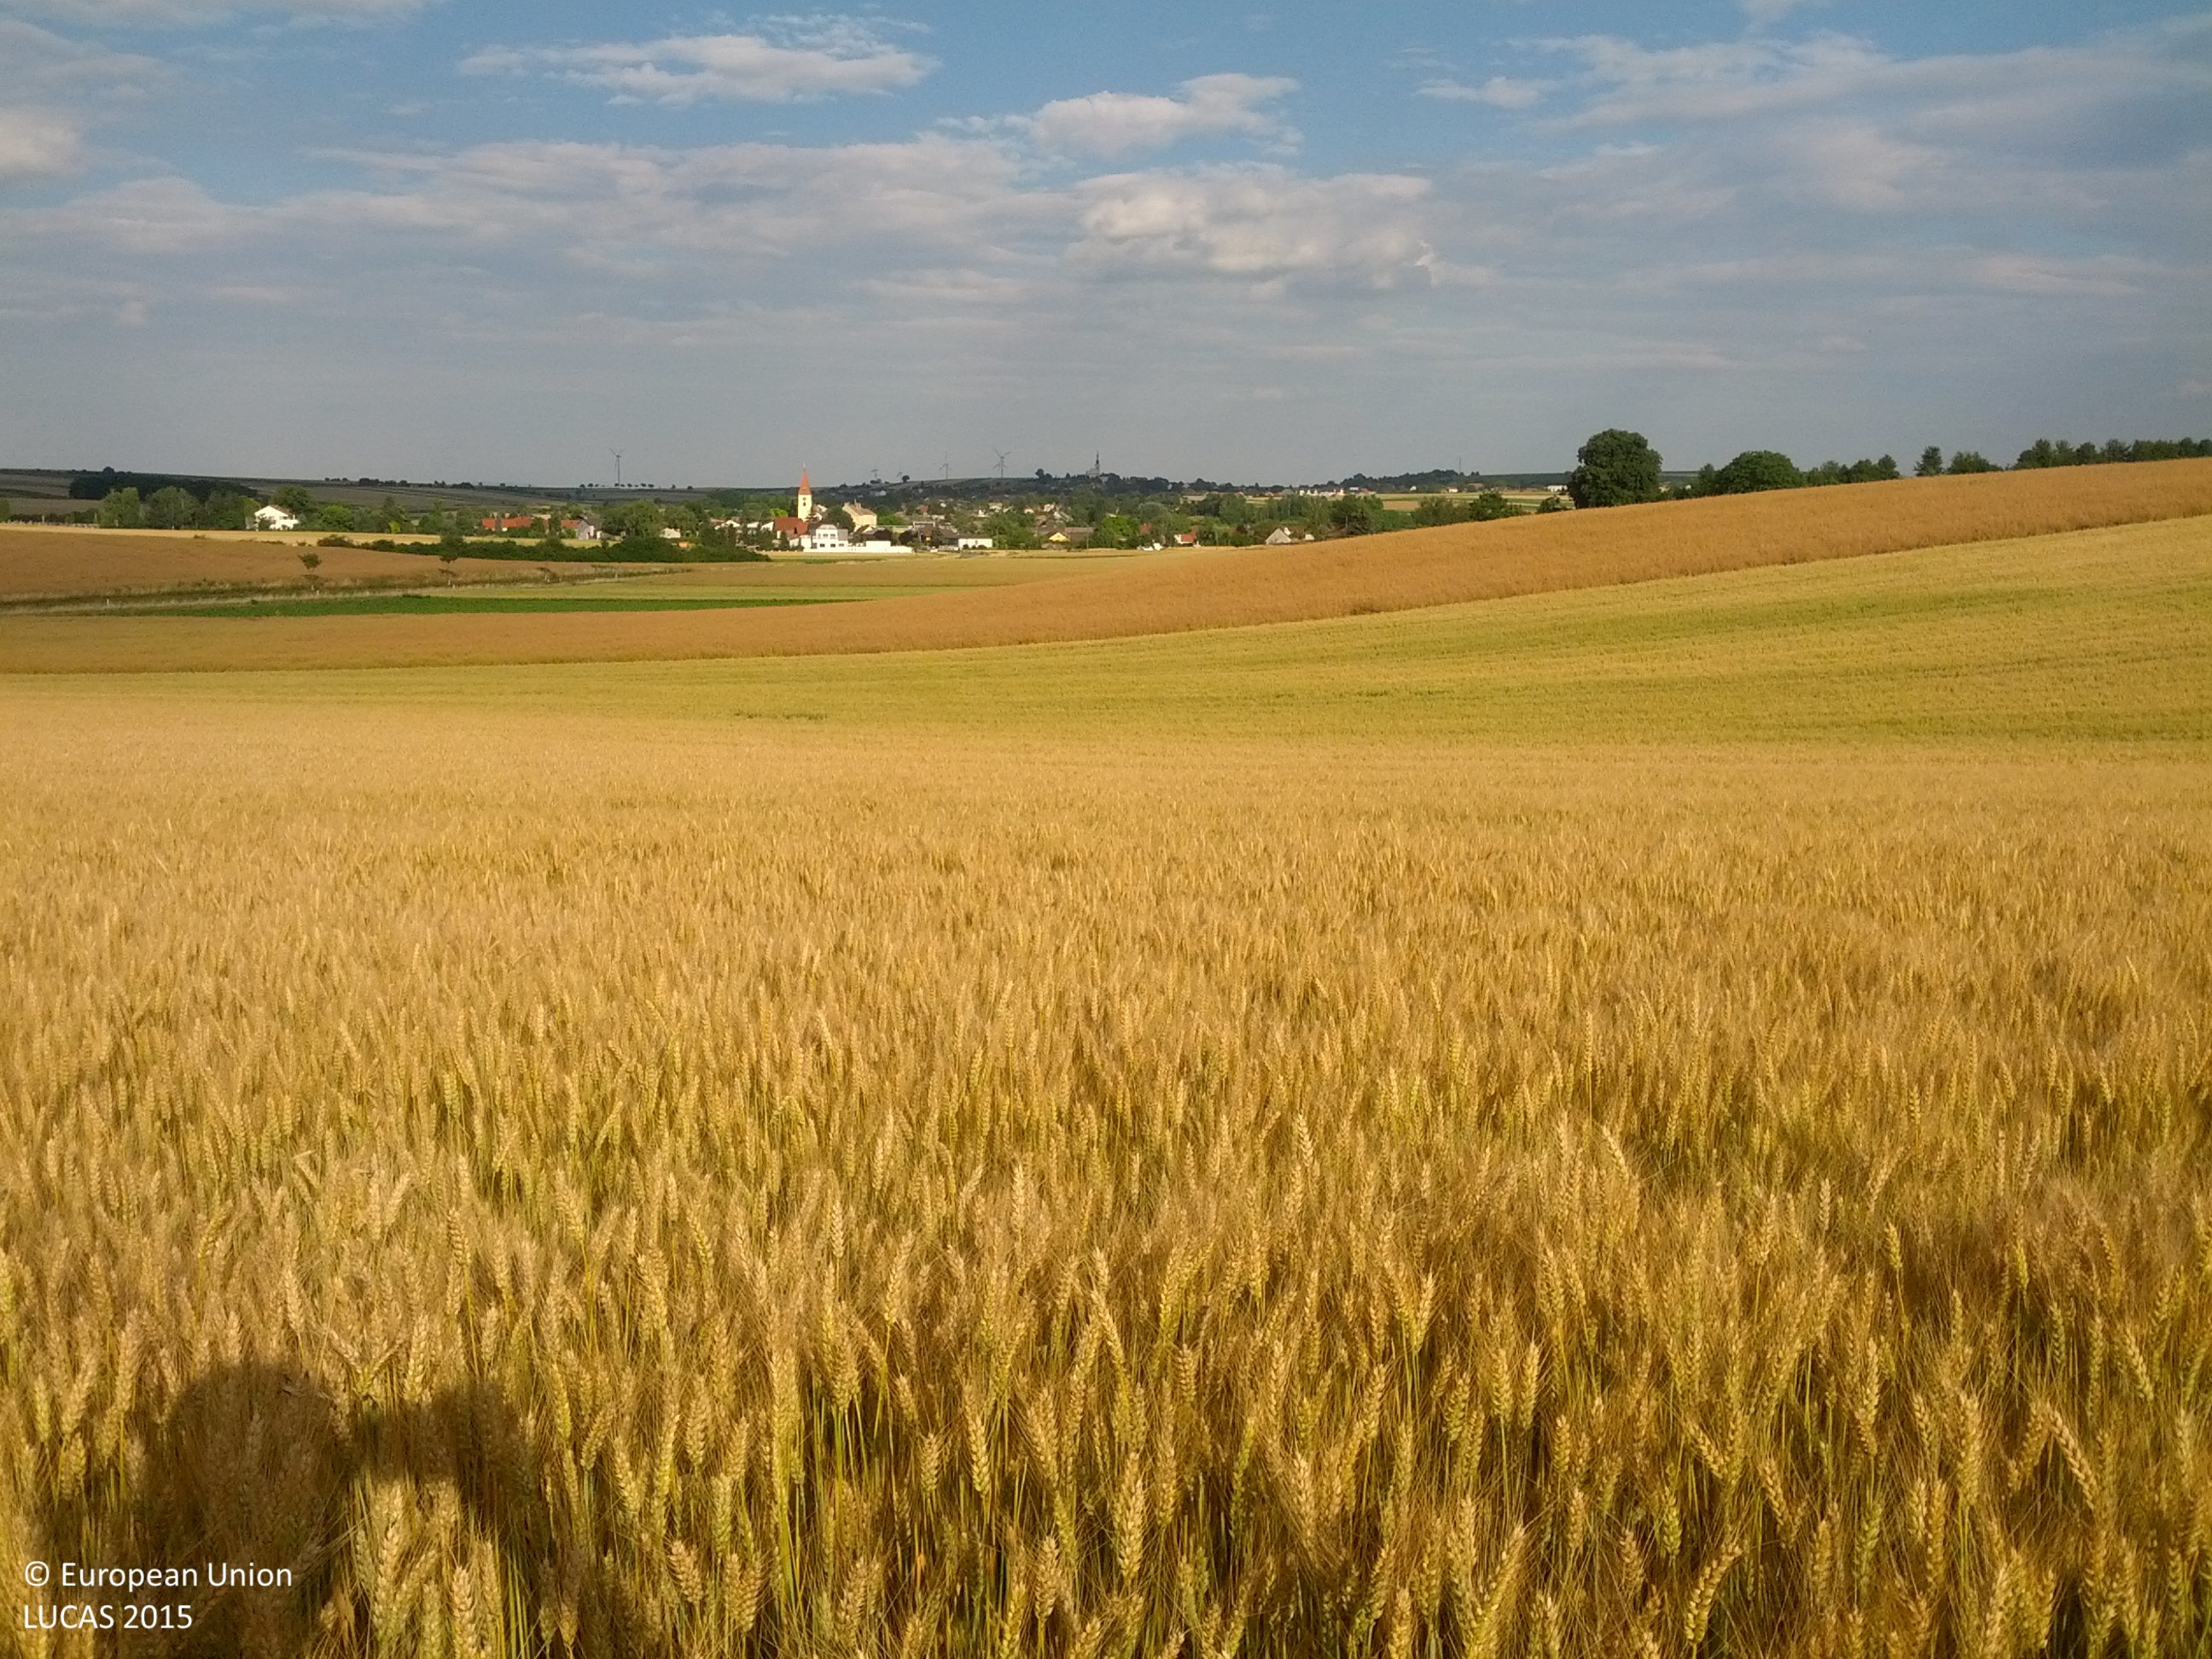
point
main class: Cropland
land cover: Common wheat
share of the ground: > 75 %
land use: Agriculture (excluding fallow land and kitchen gardens)
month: June
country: AT
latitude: 48.4758
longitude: 16.6213
